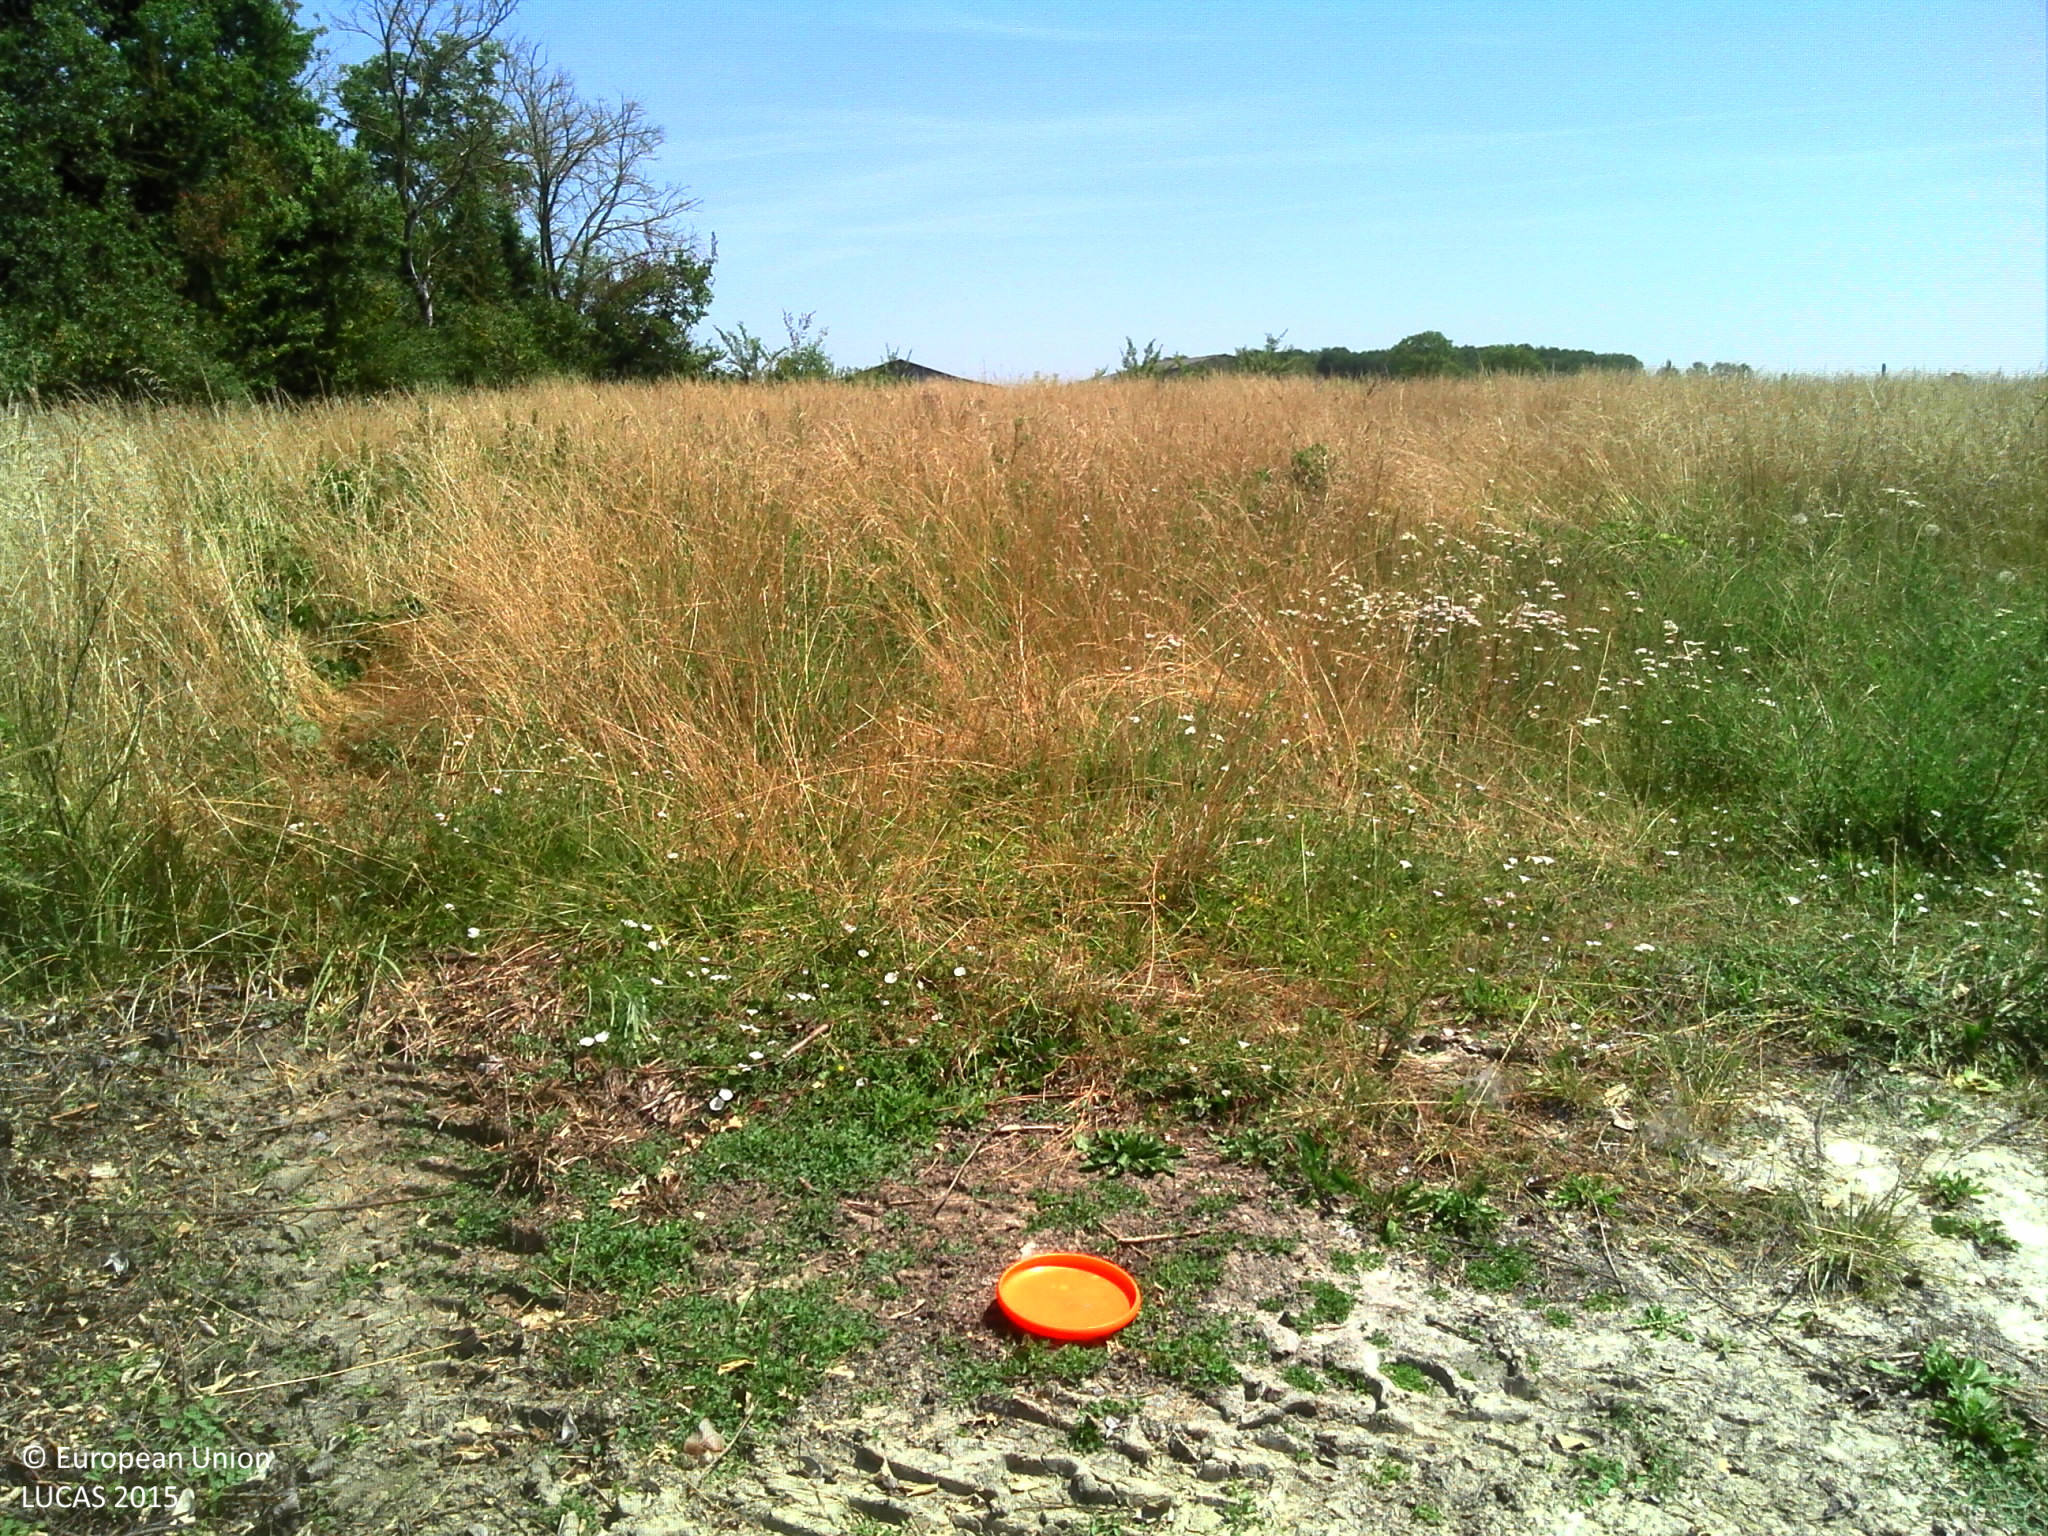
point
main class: Grassland
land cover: Grassland without tree/shrub cover
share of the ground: > 75 %
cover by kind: herbaceous plants 95 %, unconsolidated bare surface 5 %
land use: Agriculture (excluding fallow land and kitchen gardens)
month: July
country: FR
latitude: 47.2070
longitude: 0.8333
